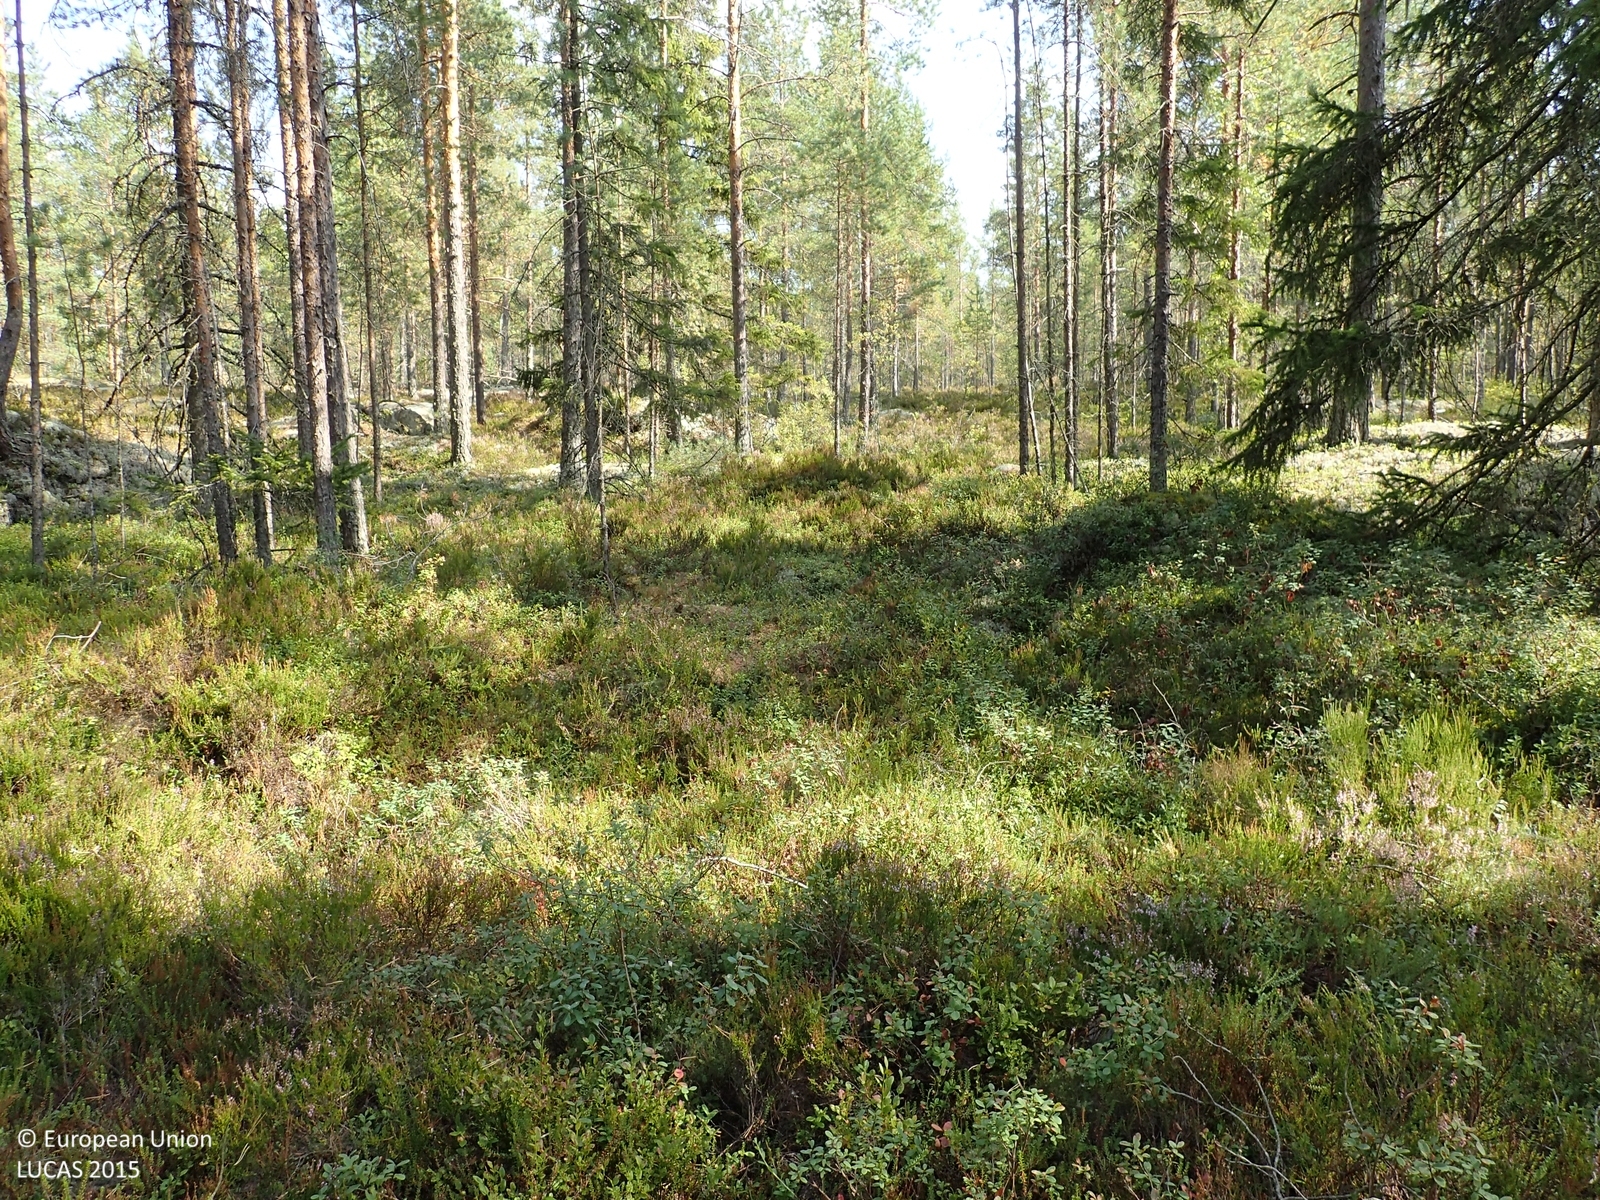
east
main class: Woodland
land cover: Pine dominated coniferous woodland
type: boreal forest
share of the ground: 50 - 75 %
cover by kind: coniferous forest trees 60 %, shrubs 30 %, lichens and mosses 10 %
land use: Forestry
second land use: Amenities, museums, leisure
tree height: > 5 m
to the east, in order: Pine dominated coniferous woodland
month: August
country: FI
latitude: 62.6897
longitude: 22.5387
